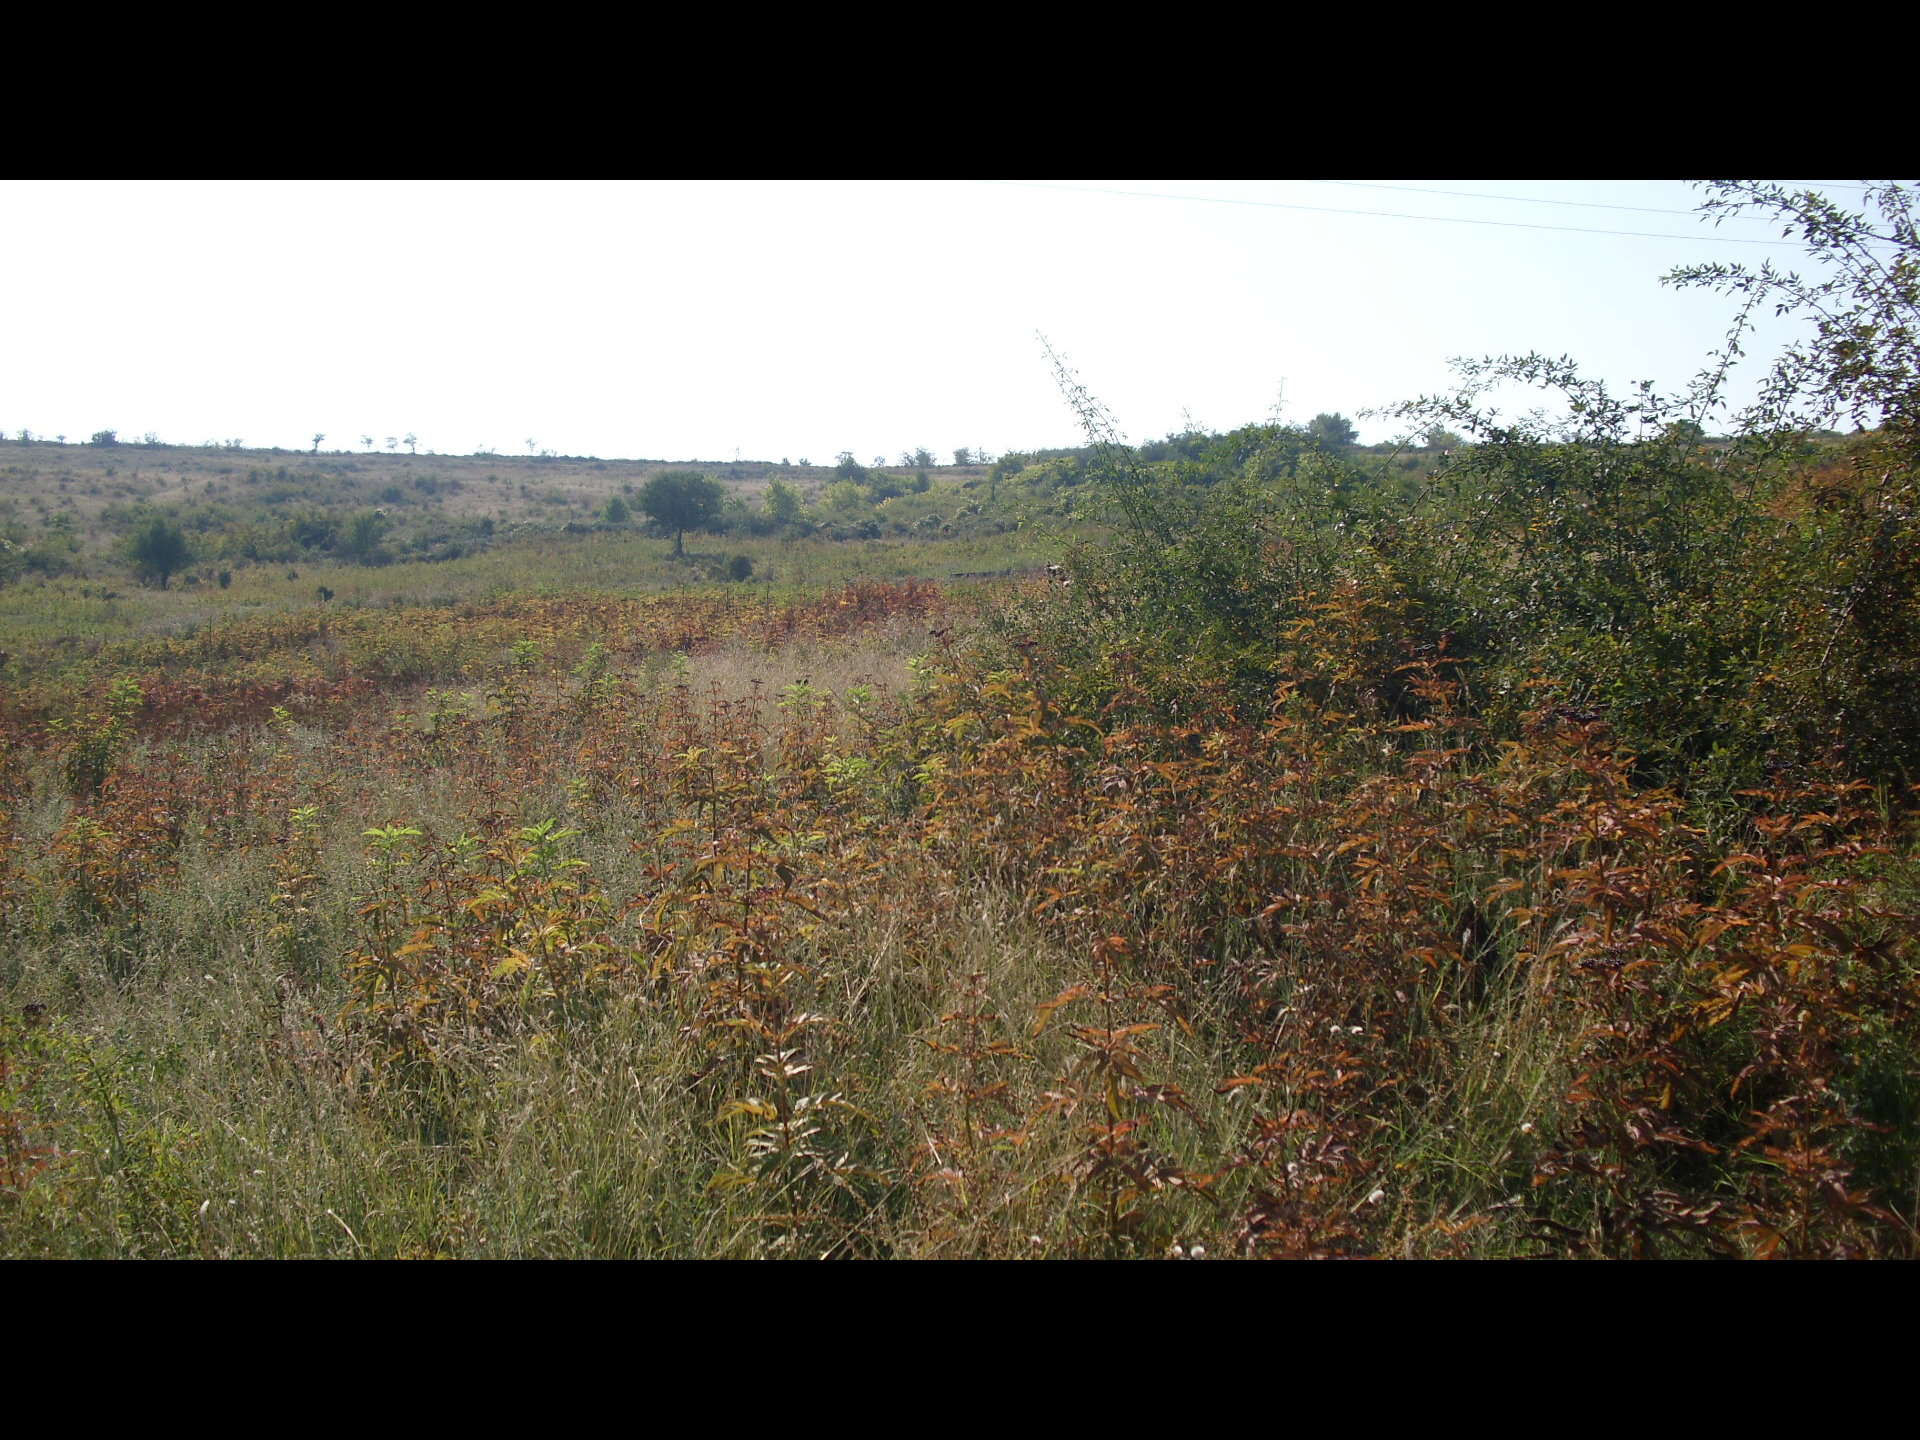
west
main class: Shrubland
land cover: Shrubland with sparse tree cover
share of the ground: > 75 %
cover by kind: herbaceous plants 85 %, shrubs 10 %, broadleaved forest trees 5 %
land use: Semi-natural and natural areas not in use
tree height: < 5 m
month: August
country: BG
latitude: 44.0490
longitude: 22.7820
